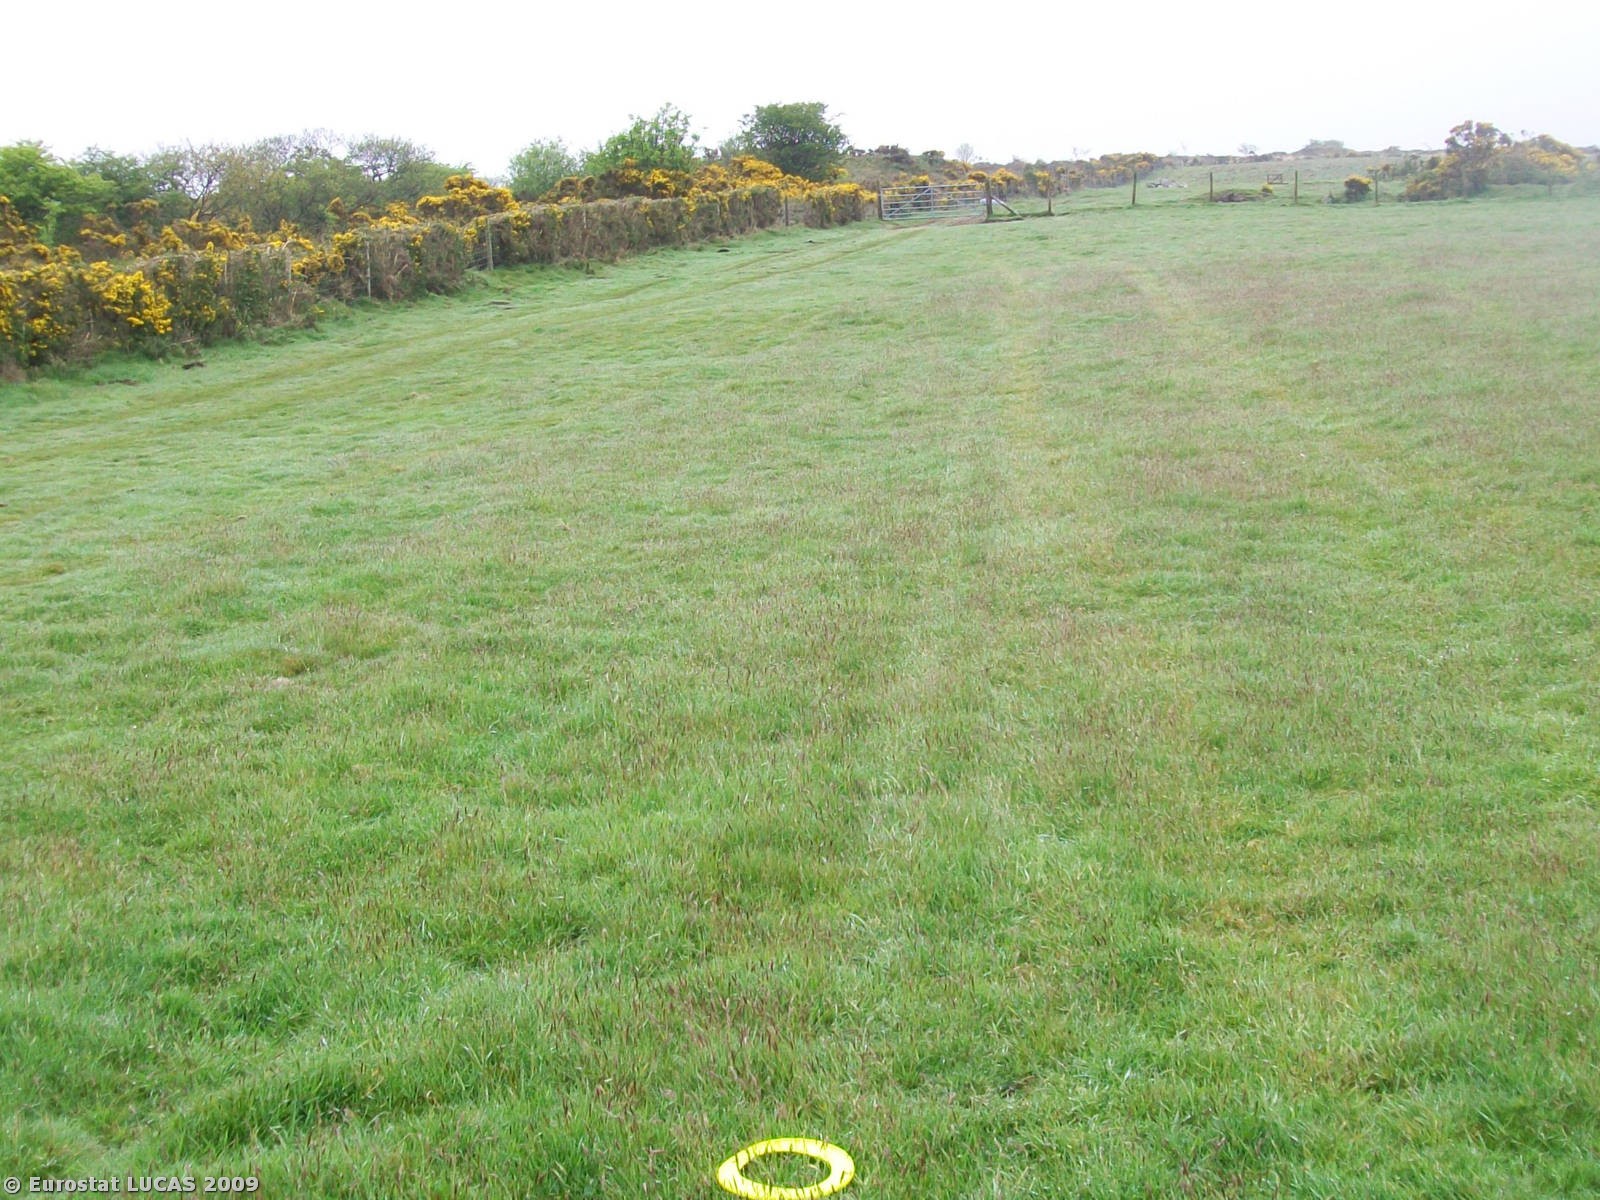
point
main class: Grassland
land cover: Grassland without tree/shrub cover
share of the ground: > 75 %
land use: Agriculture (excluding fallow land and kitchen gardens)
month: May
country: GB
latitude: 50.5187
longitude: -4.3027
